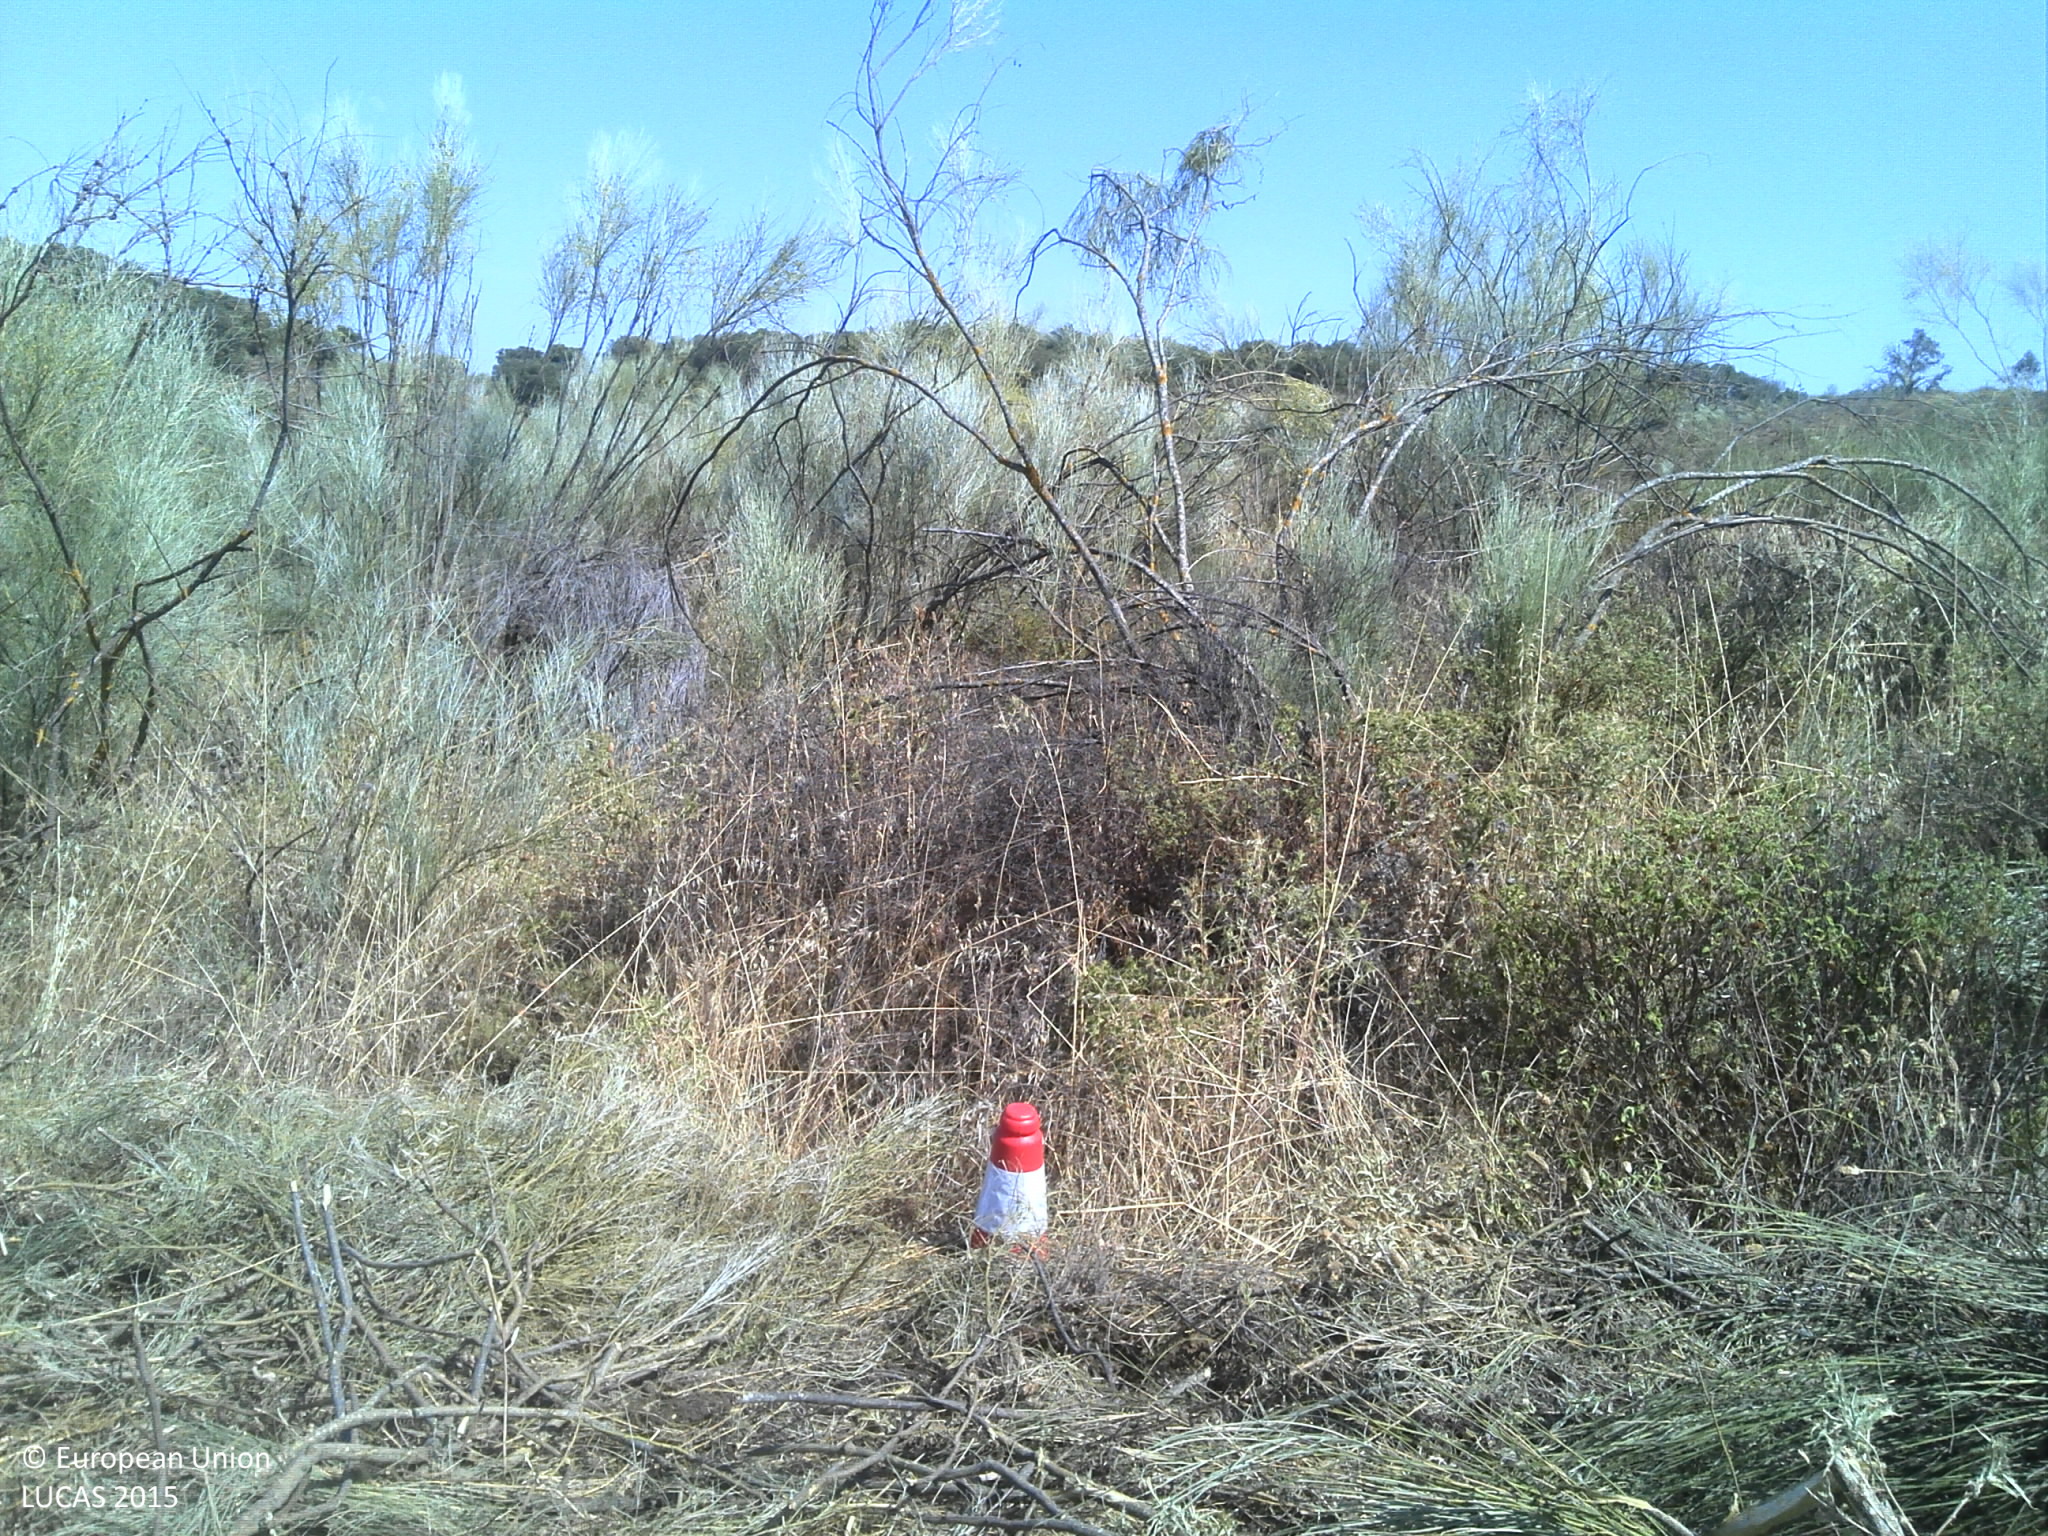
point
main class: Shrubland
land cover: Shrubland without tree cover
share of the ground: > 75 %
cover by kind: shrubs 75 %, herbaceous plants 20 %, unconsolidated bare surface 5 %
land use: Abandoned areas
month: June
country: PT
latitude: 39.7250
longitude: -7.1337
